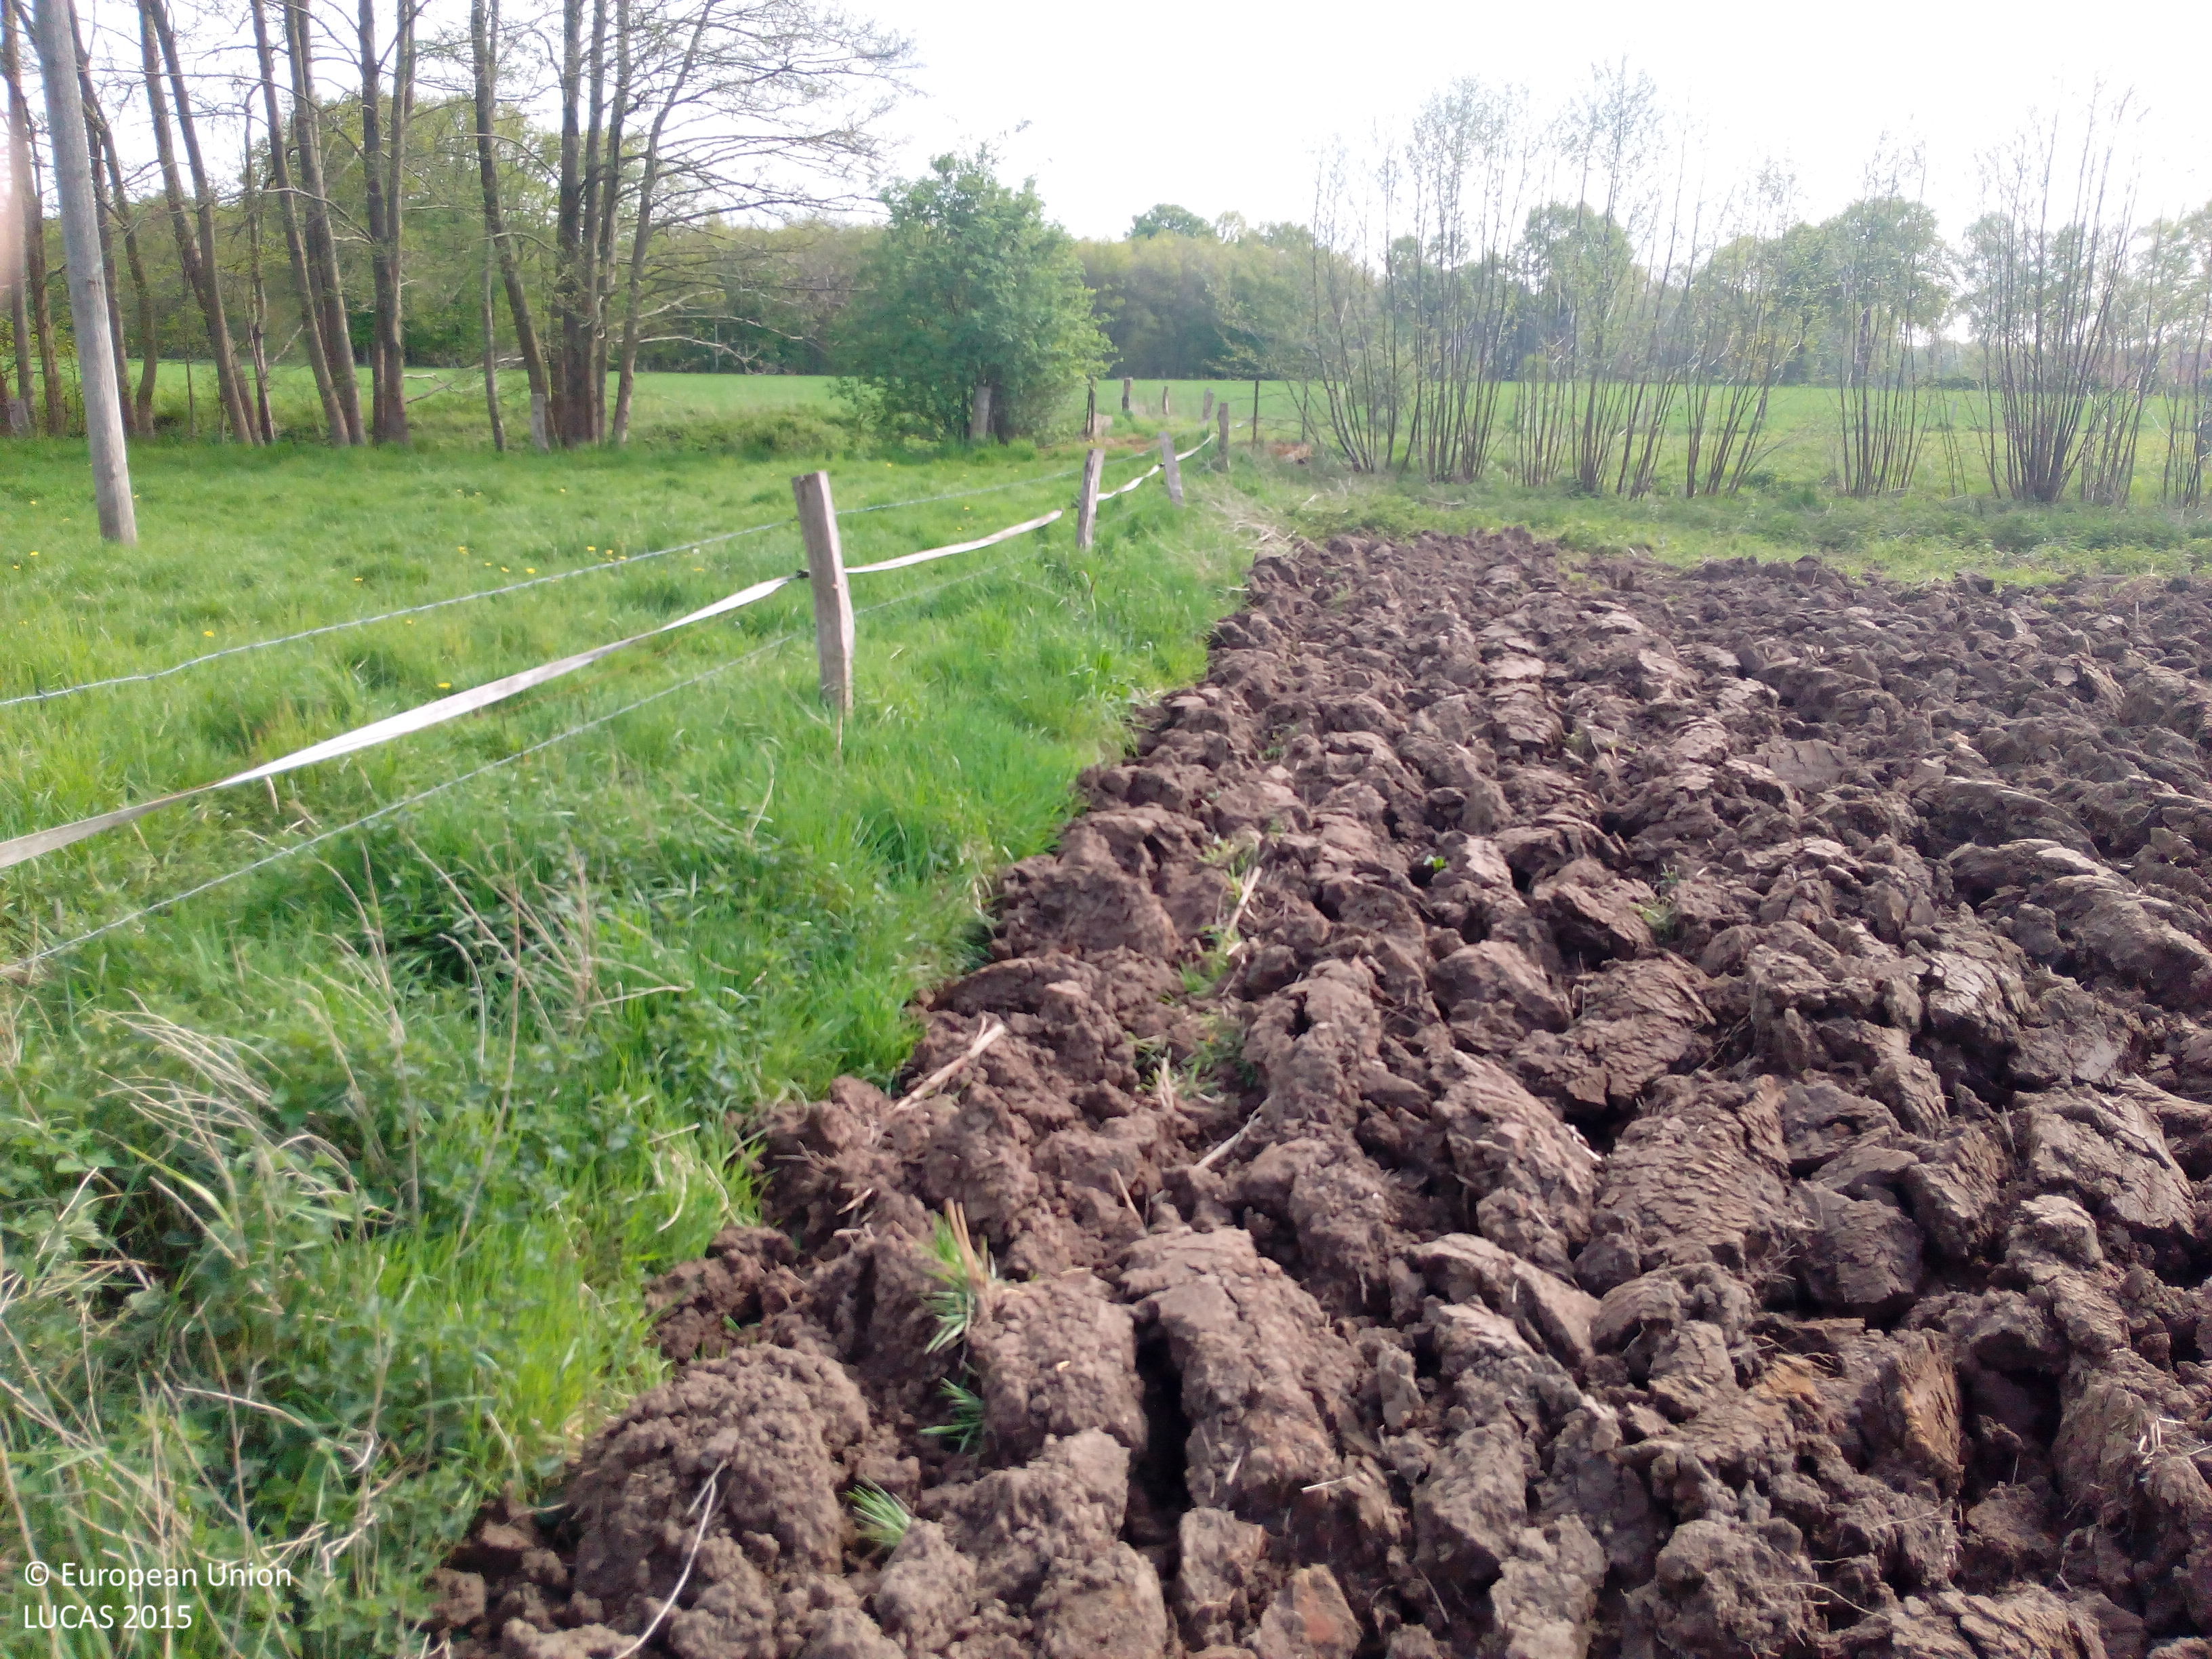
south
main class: Cropland
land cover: Maize
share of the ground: < 10 %
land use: Agriculture (excluding fallow land and kitchen gardens)
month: May
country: DE
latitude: 51.8276
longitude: 7.4030
